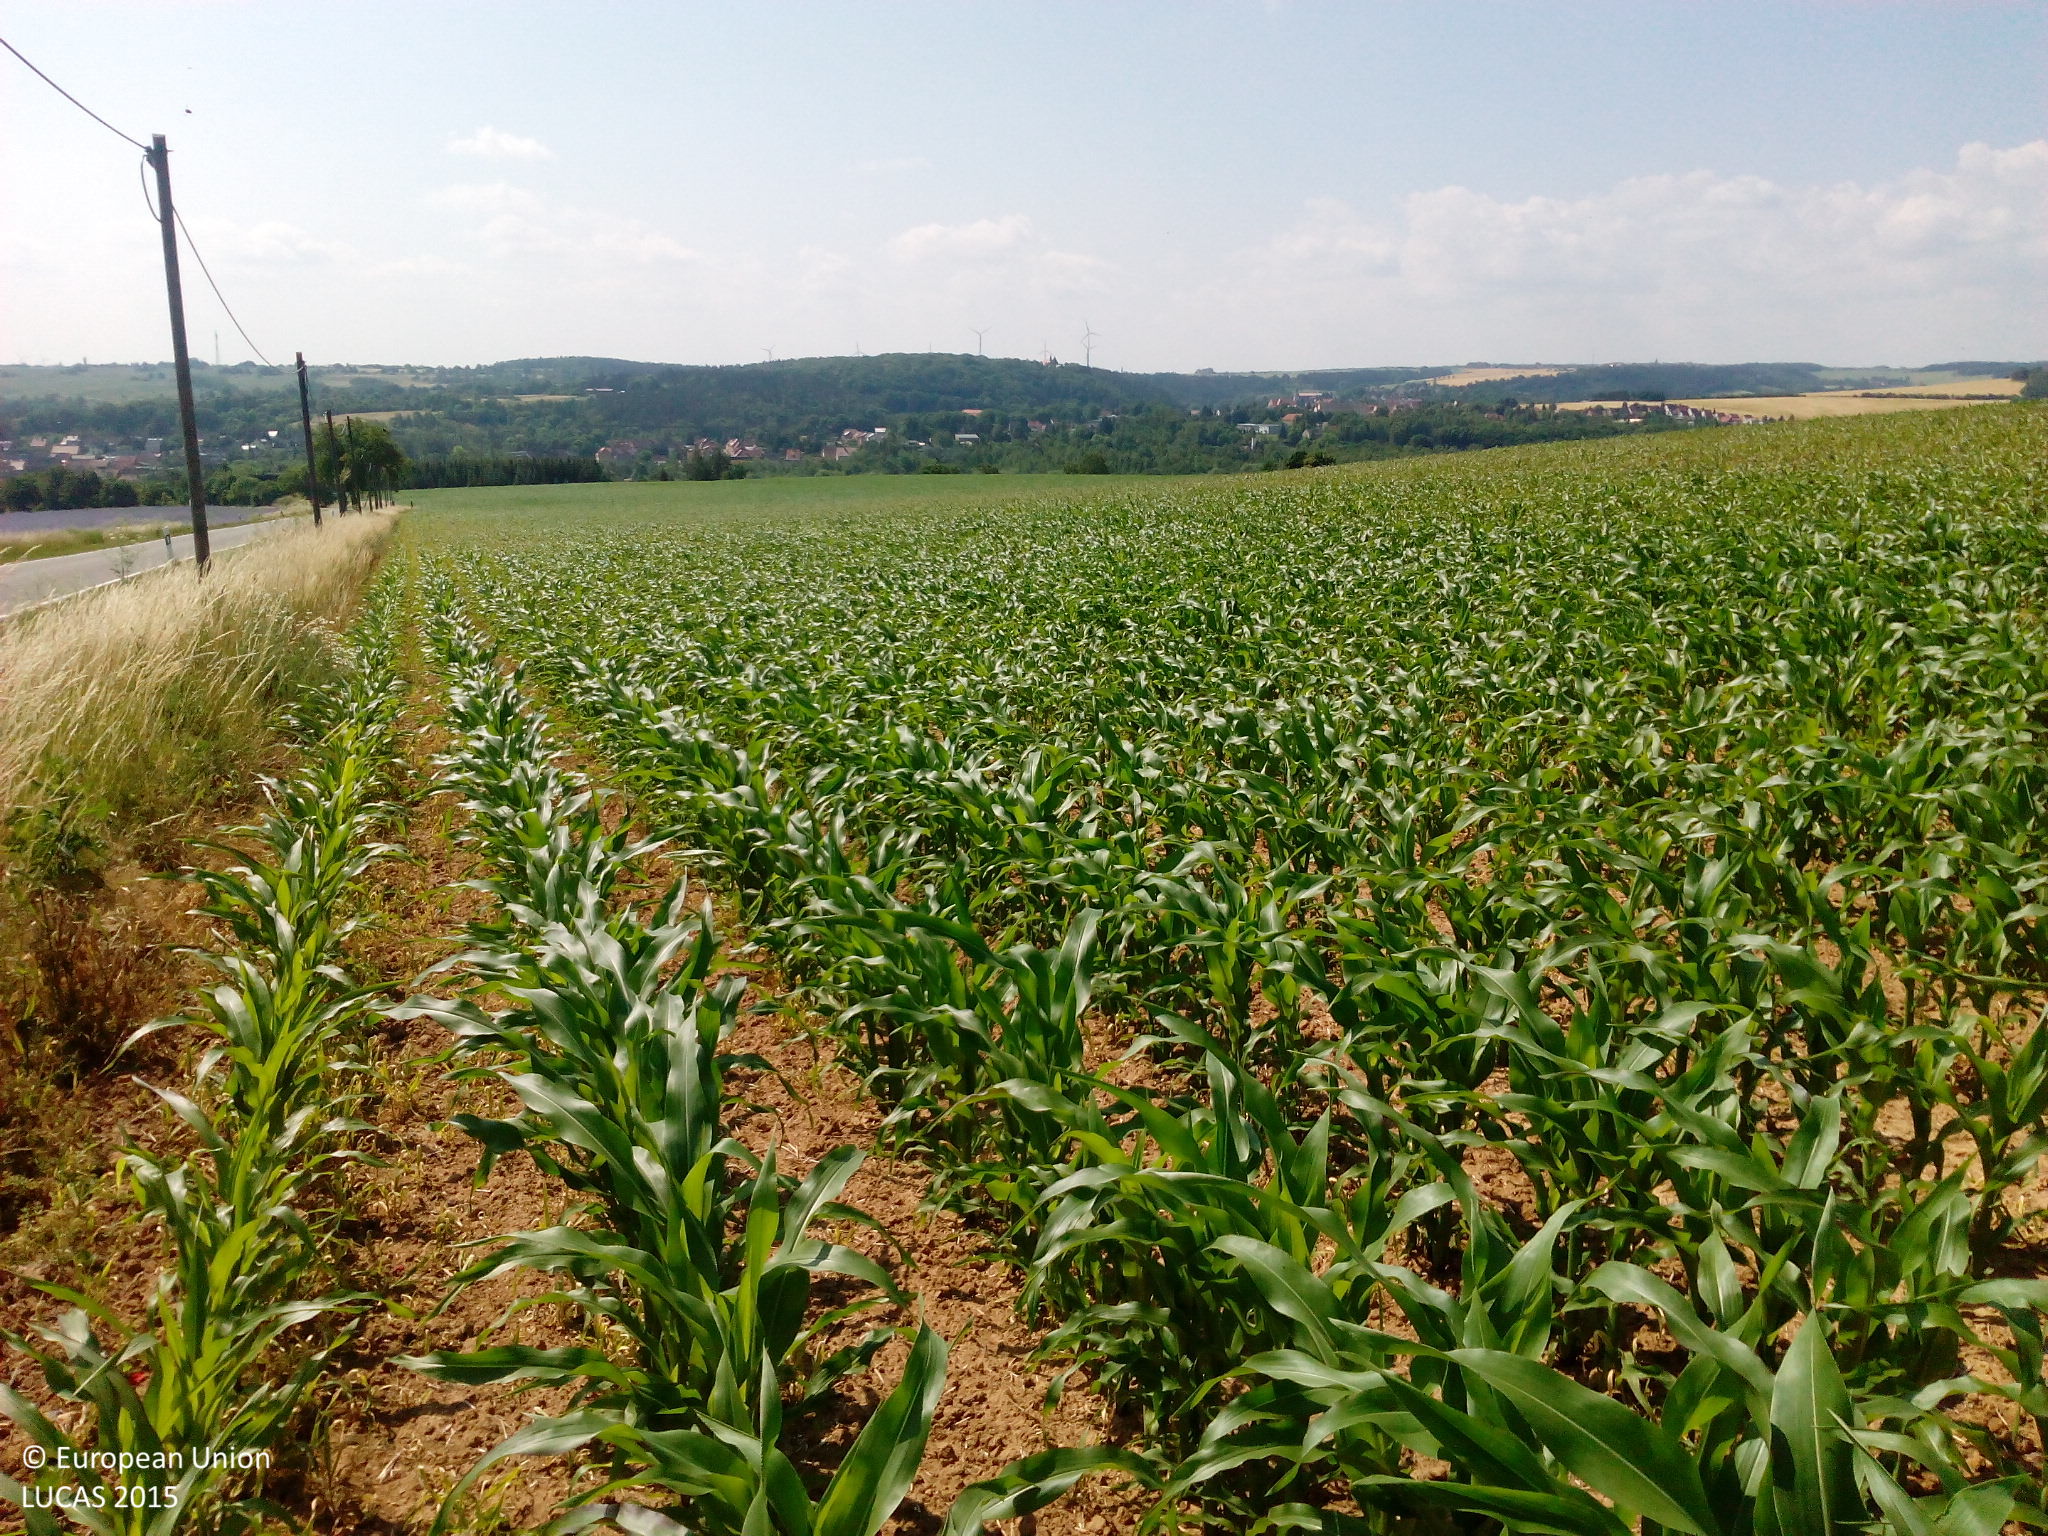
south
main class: Cropland
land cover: Maize
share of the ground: > 75 %
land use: Agriculture (excluding fallow land and kitchen gardens)
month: June
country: DE
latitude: 51.6135
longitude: 11.4582
